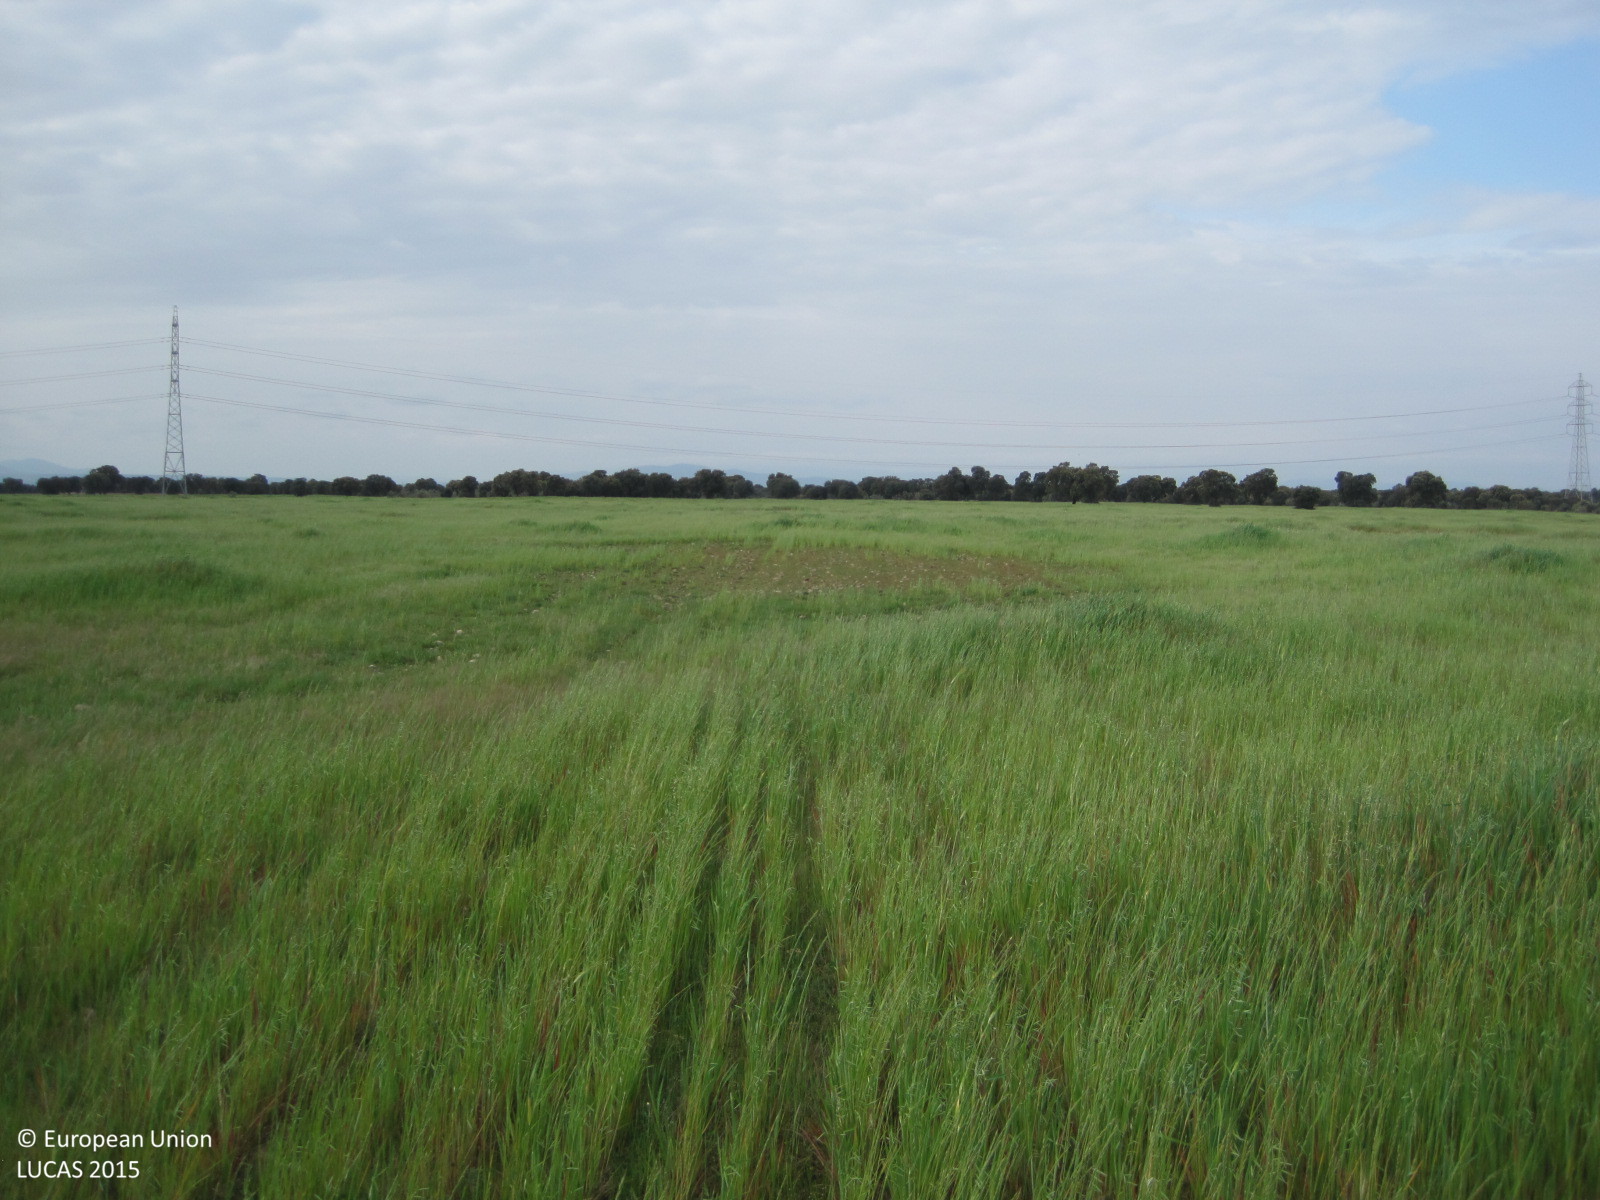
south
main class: Cropland
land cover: Mixed cereals for fodder
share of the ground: > 75 %
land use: Agriculture (excluding fallow land and kitchen gardens)
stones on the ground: 25 - 50 %
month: April
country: ES
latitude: 39.9378
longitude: -4.9706
